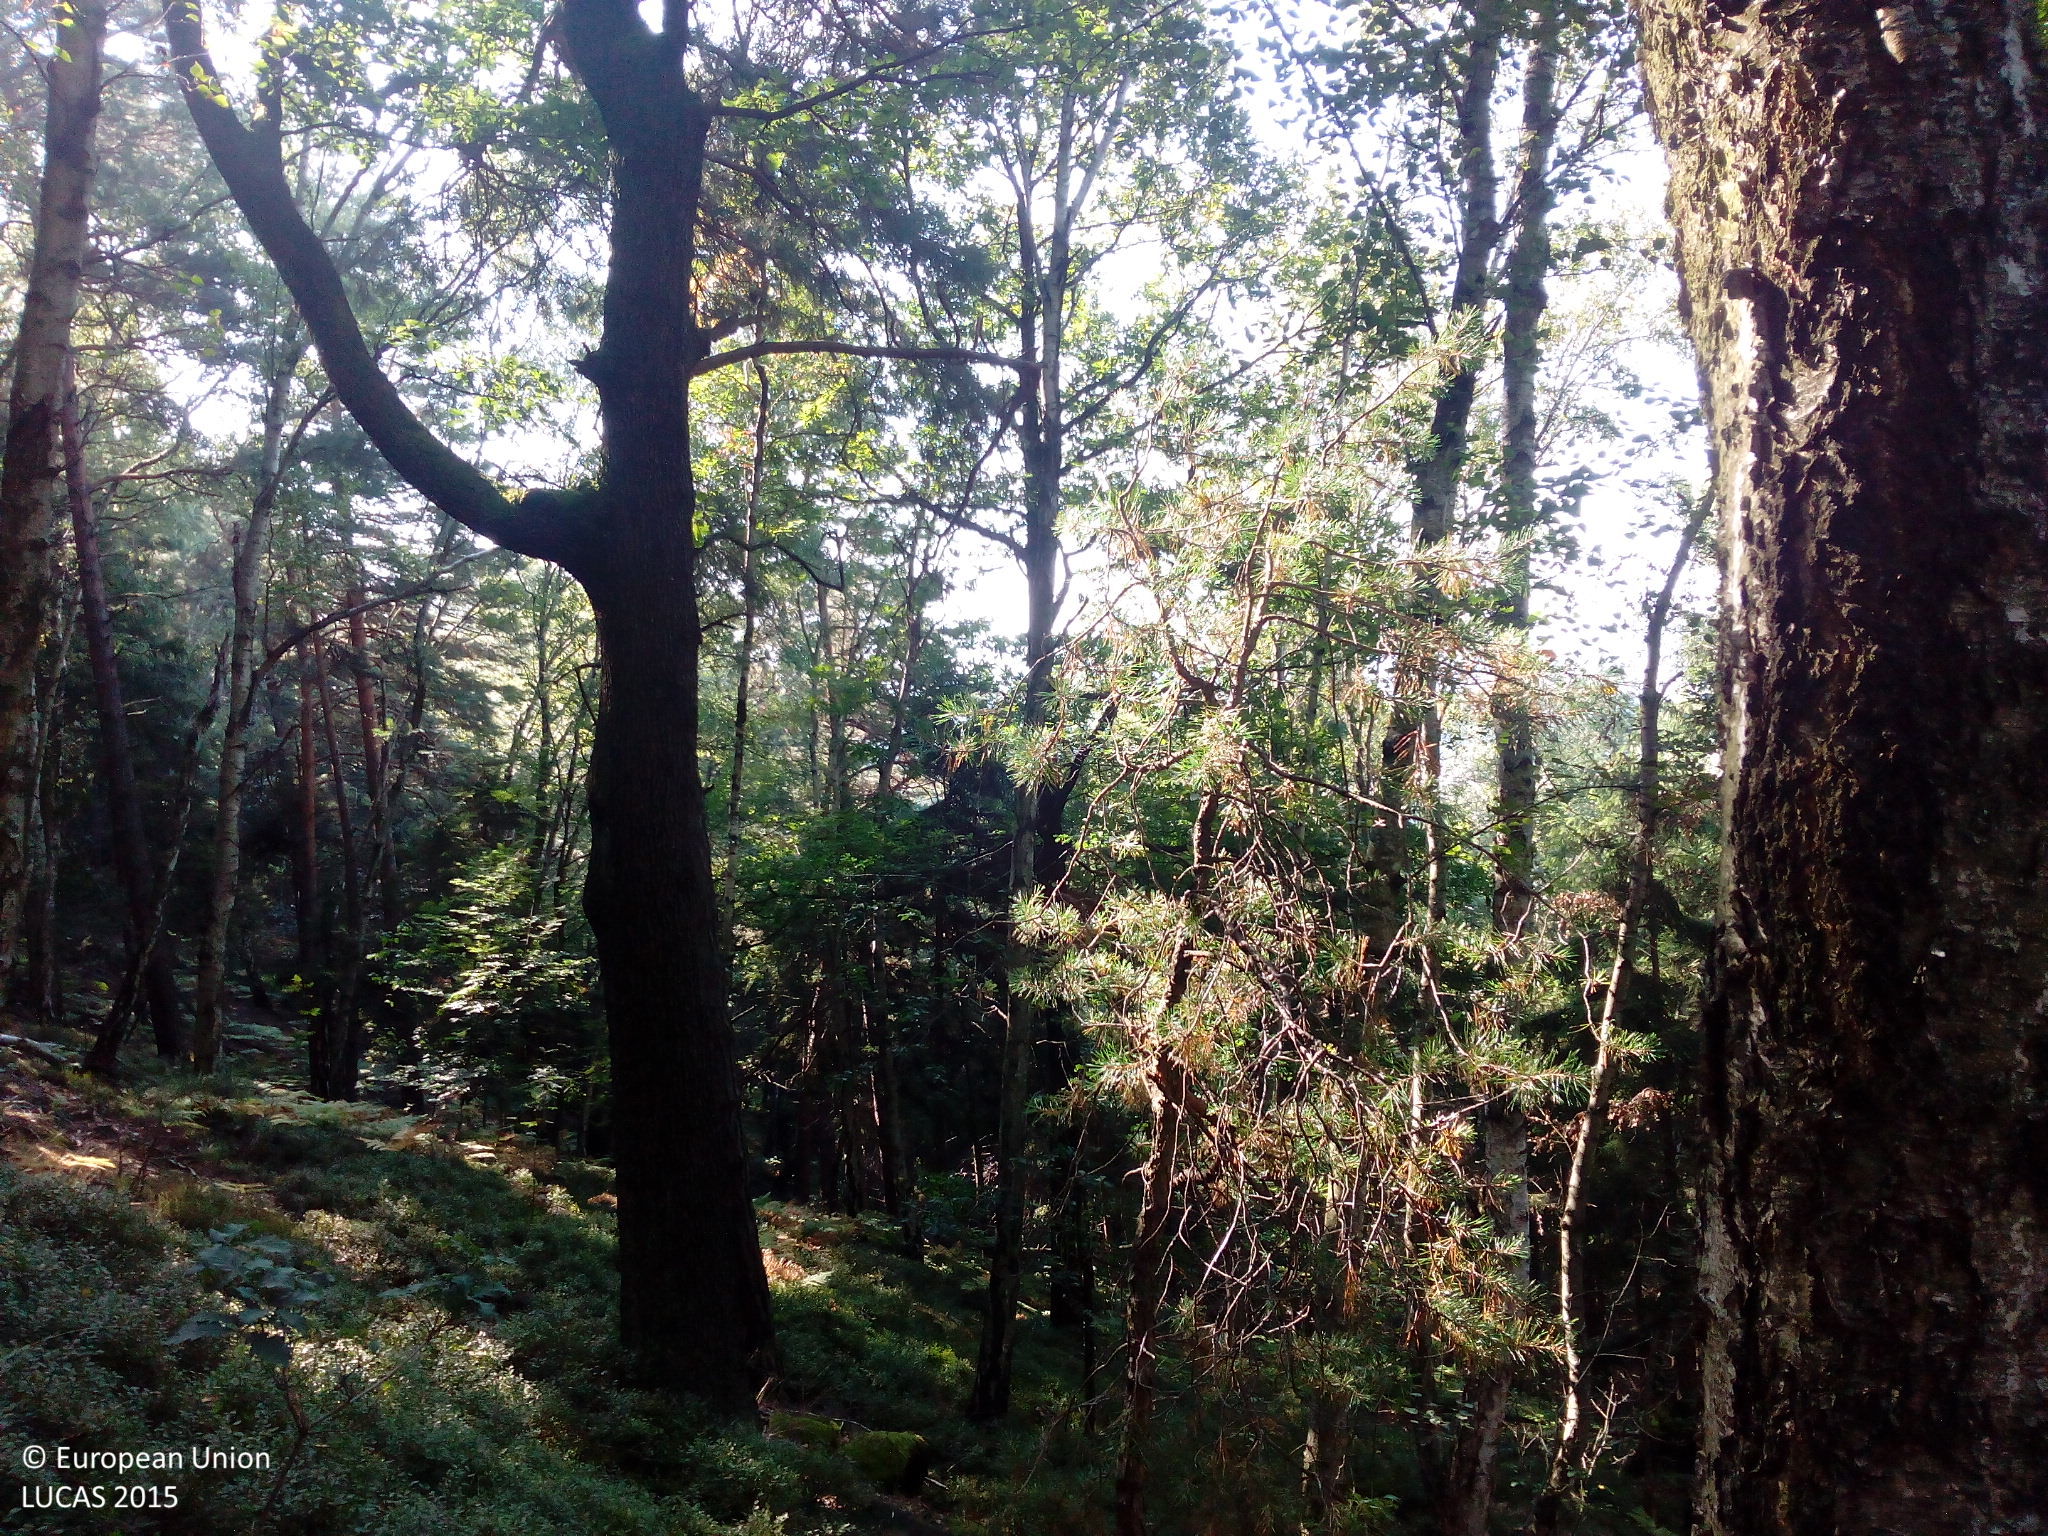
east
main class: Woodland
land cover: Pine dominated mixed woodland
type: hemiboreal forest and nemoral coniferous forest and mixed broadleaved-coniferous forest
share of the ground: > 75 %
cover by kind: coniferous forest trees 60 %, broadleaved forest trees 40 %
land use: Forestry
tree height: > 5 m
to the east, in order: Pine dominated mixed woodland; Tracks; Pine dominated mixed woodland; Tracks; Pine dominated coniferous woodland
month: August
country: DE
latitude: 50.9063
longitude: 13.9971
